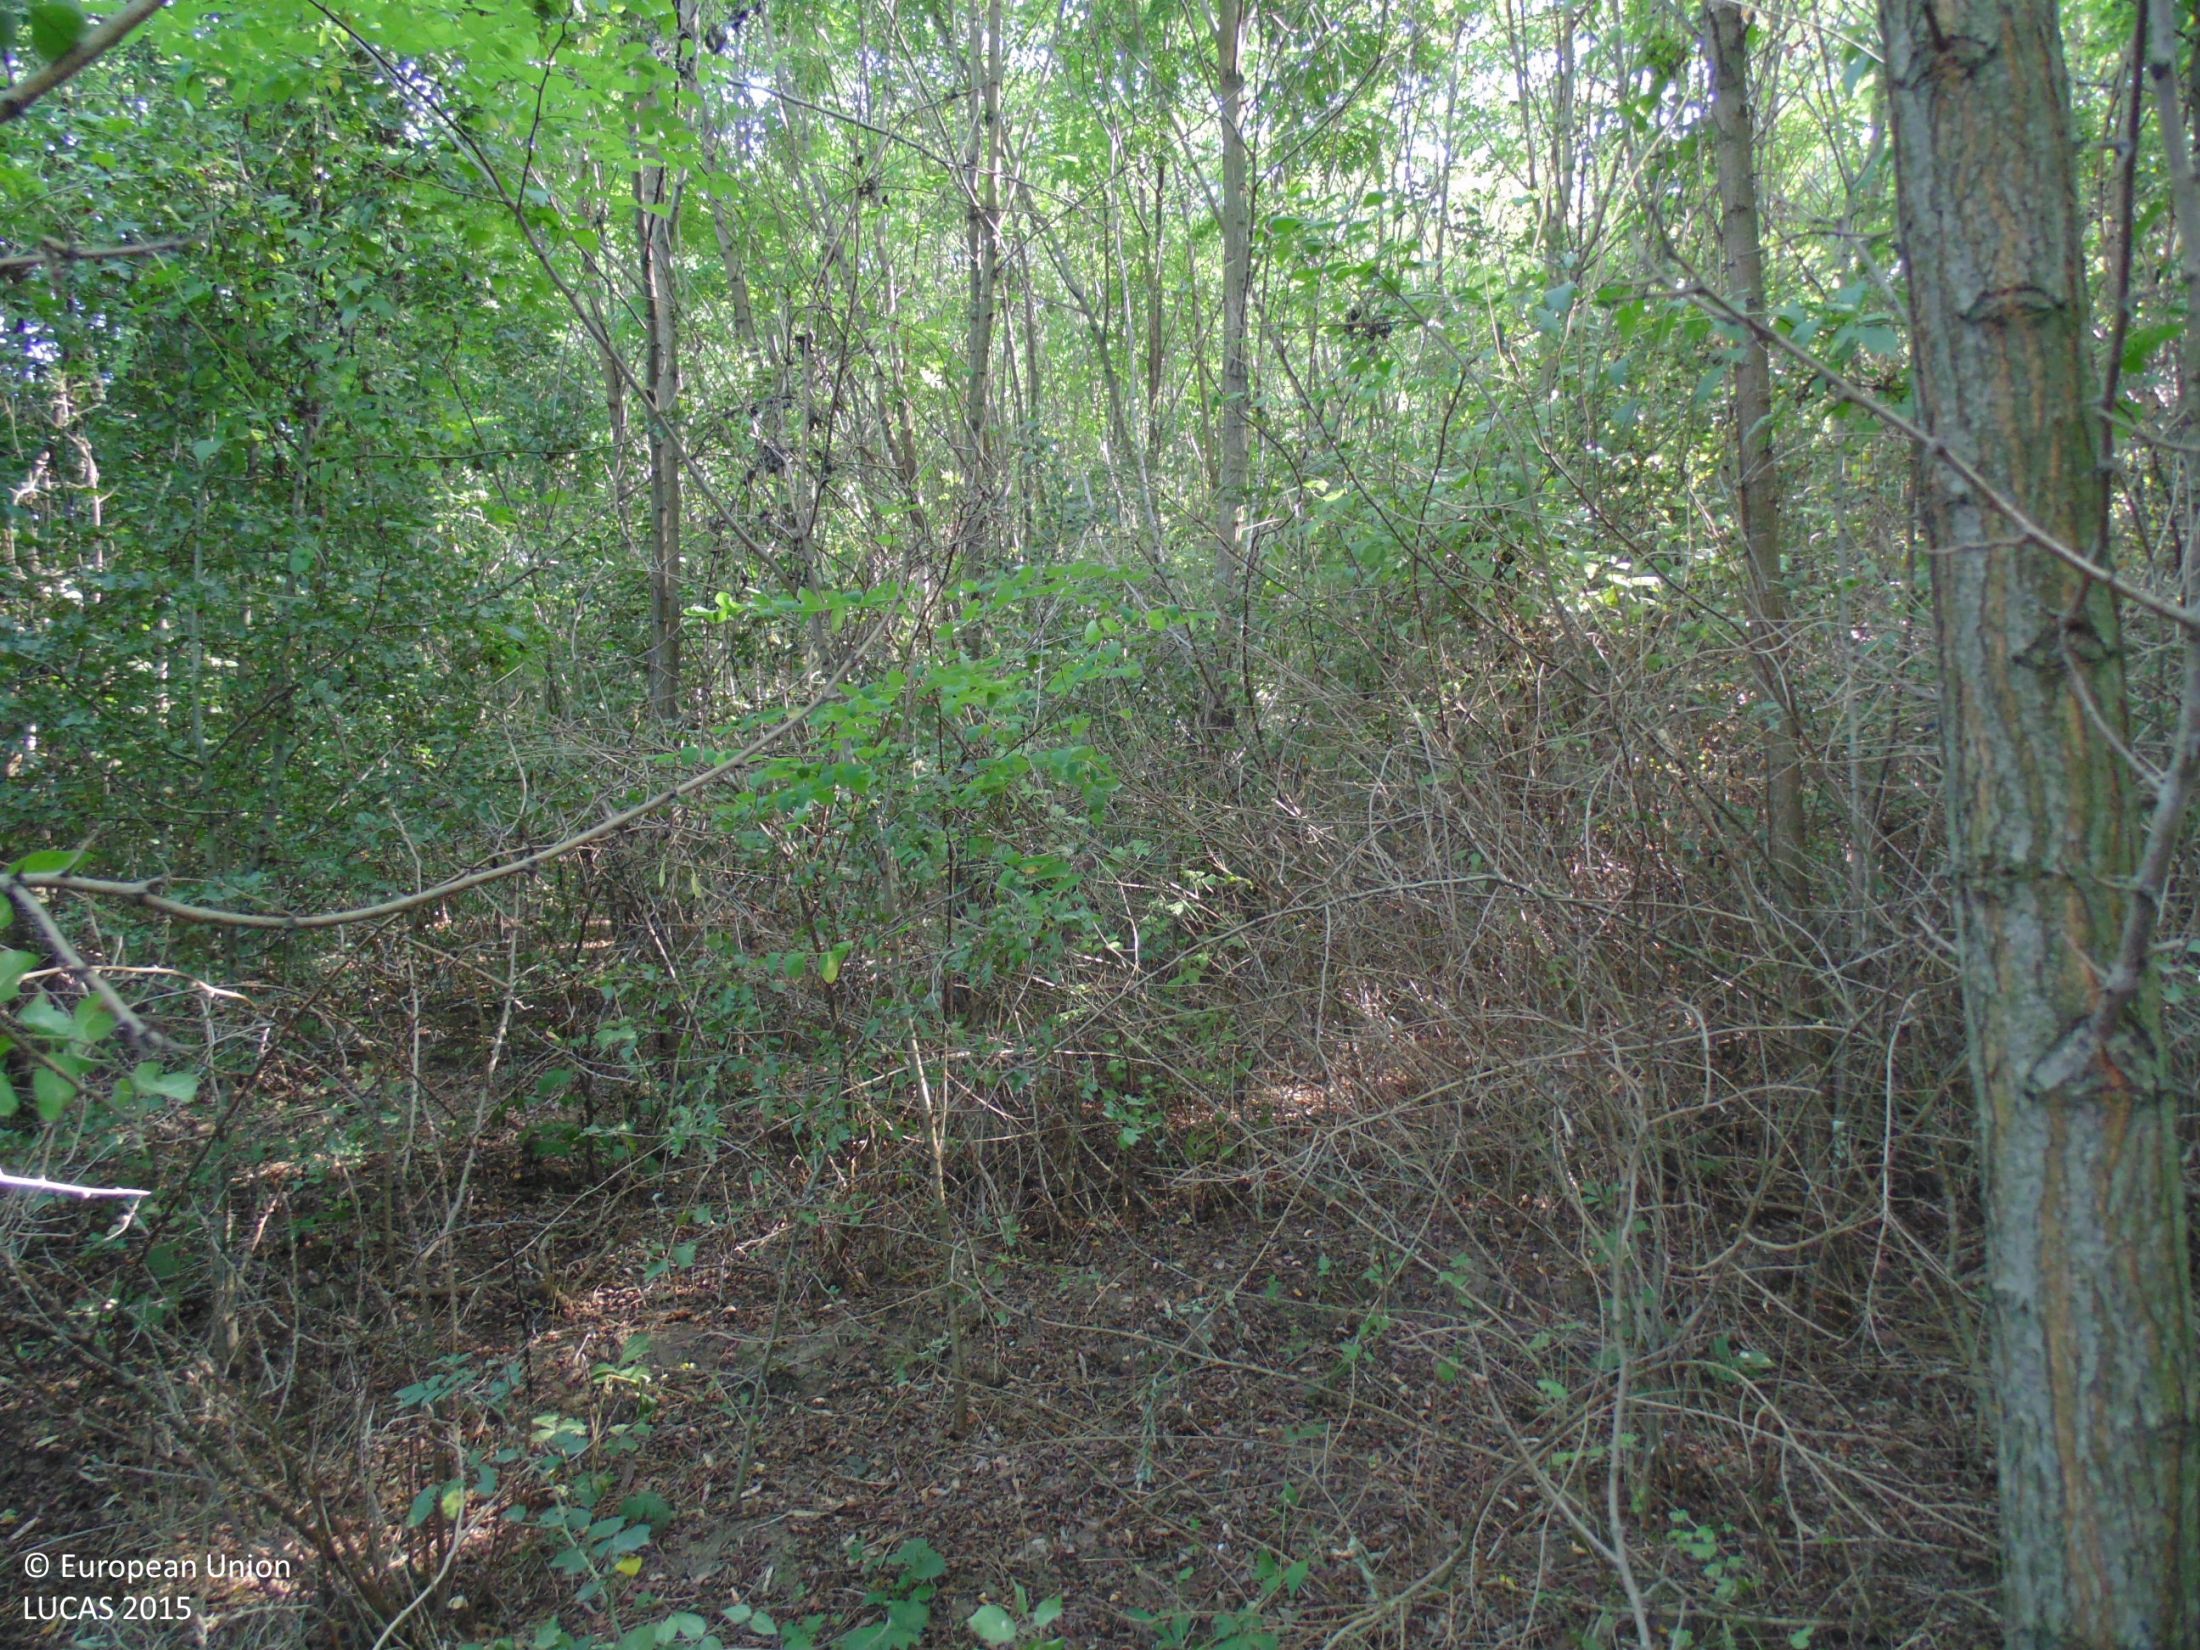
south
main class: Woodland
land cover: Broadleaved woodland
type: mesophytic deciduous forest
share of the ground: > 75 %
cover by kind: broadleaved forest trees 90 %, shrubs 5 %, unconsolidated bare surface 5 %
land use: Forestry
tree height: > 5 m
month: August
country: BG
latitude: 43.9238
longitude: 27.3574
